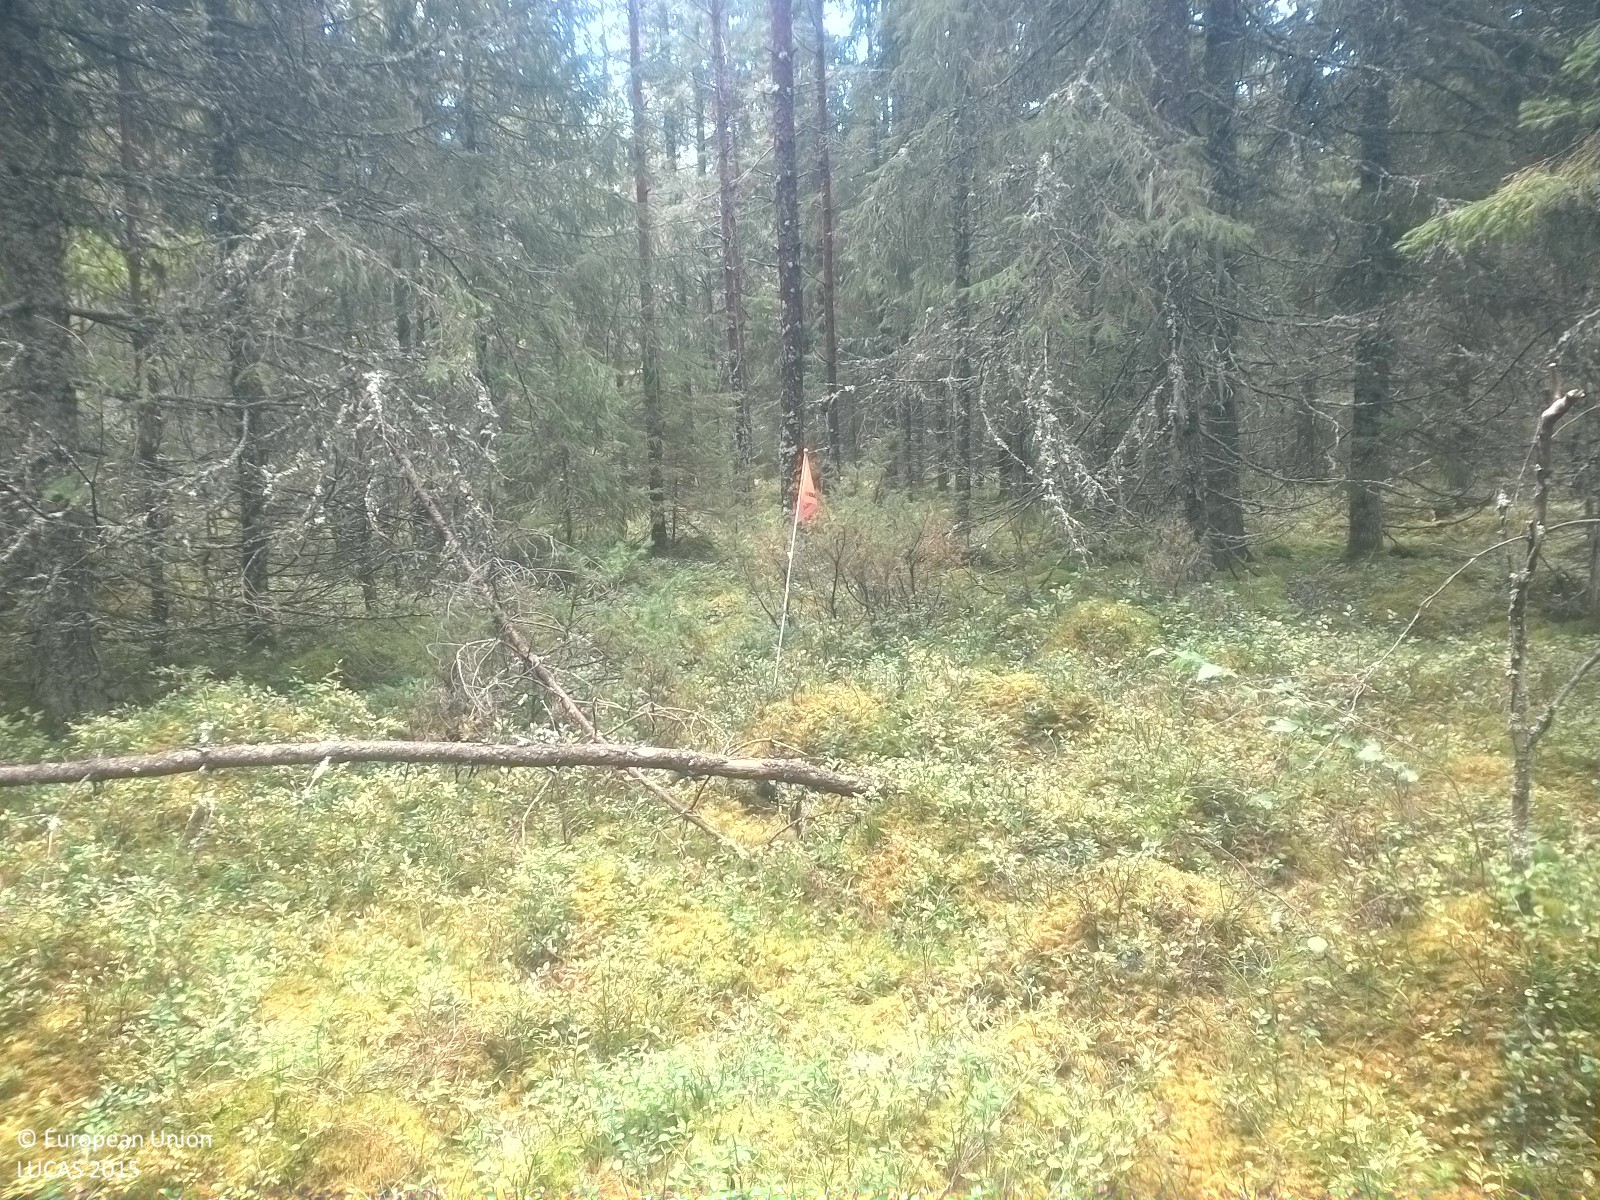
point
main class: Woodland
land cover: Spruce dominated coniferous woodland
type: boreal forest
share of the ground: 25 - 50 %
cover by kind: coniferous forest trees 40 %, herbaceous plants 25 %, lichens and mosses 25 %, broadleaved forest trees 5 %, shrubs 5 %
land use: Forestry
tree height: > 5 m
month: September
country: SE
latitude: 59.3985
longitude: 15.6801
